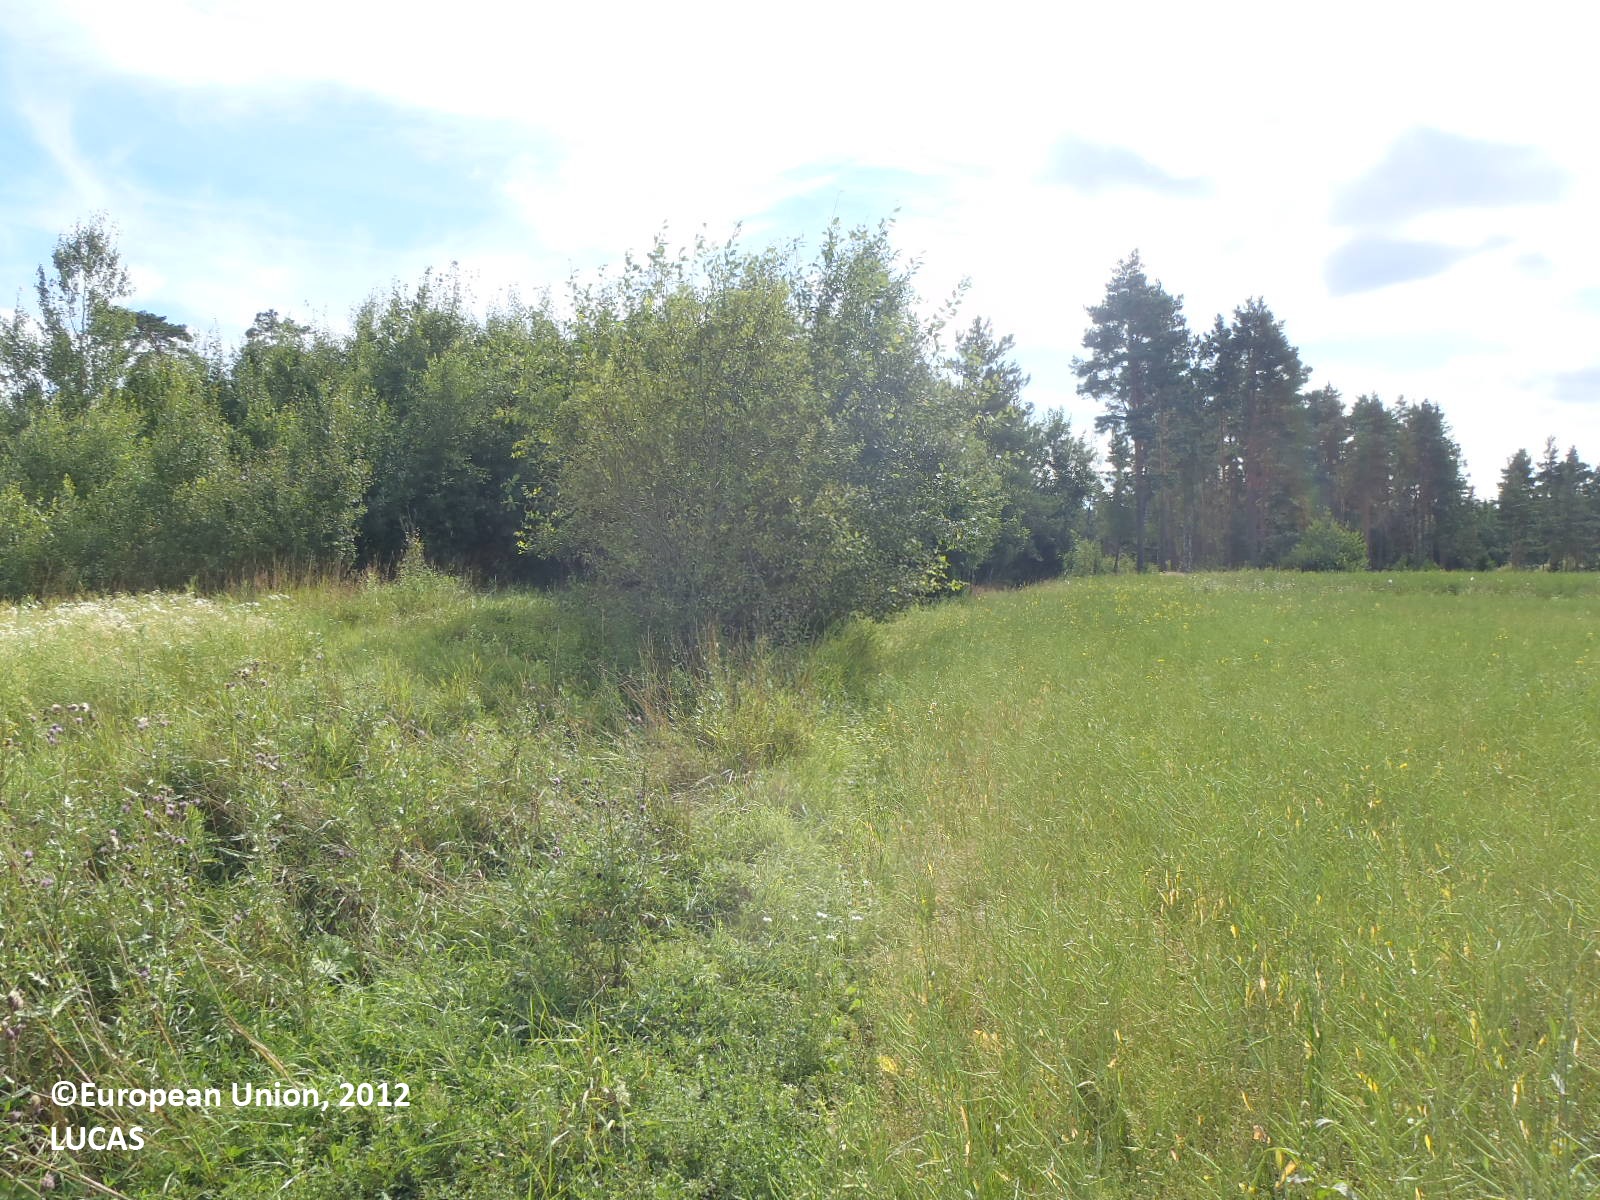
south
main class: Cropland
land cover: Rape and turnip rape
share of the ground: > 75 %
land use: Agriculture (excluding fallow land and kitchen gardens)
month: August
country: FI
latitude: 60.3360
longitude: 22.4791
